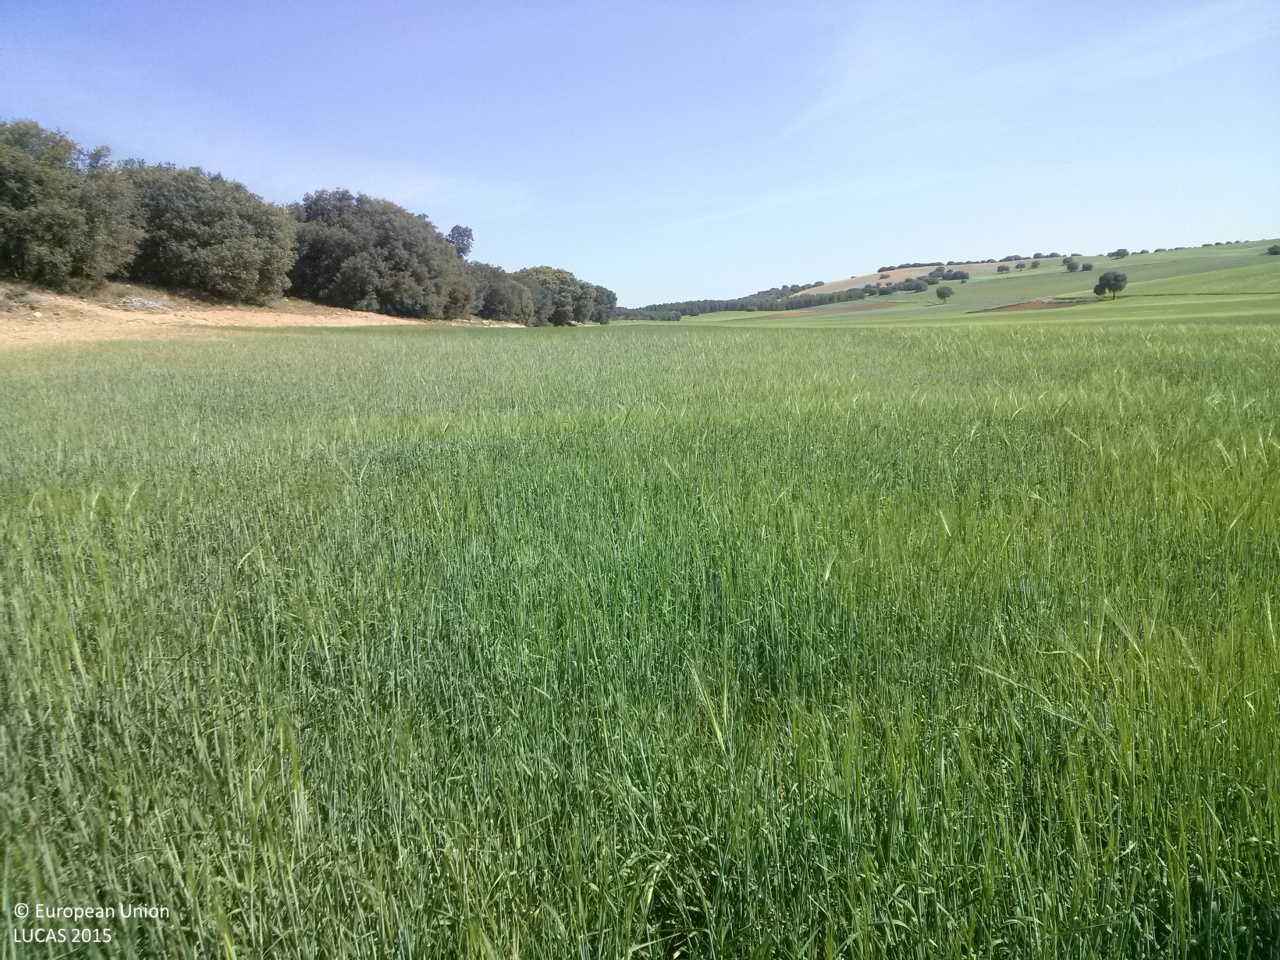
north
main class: Cropland
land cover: Barley
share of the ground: > 75 %
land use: Agriculture (excluding fallow land and kitchen gardens)
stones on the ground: 10 - 25 %
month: May
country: ES
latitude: 39.8616
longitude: -2.8201
